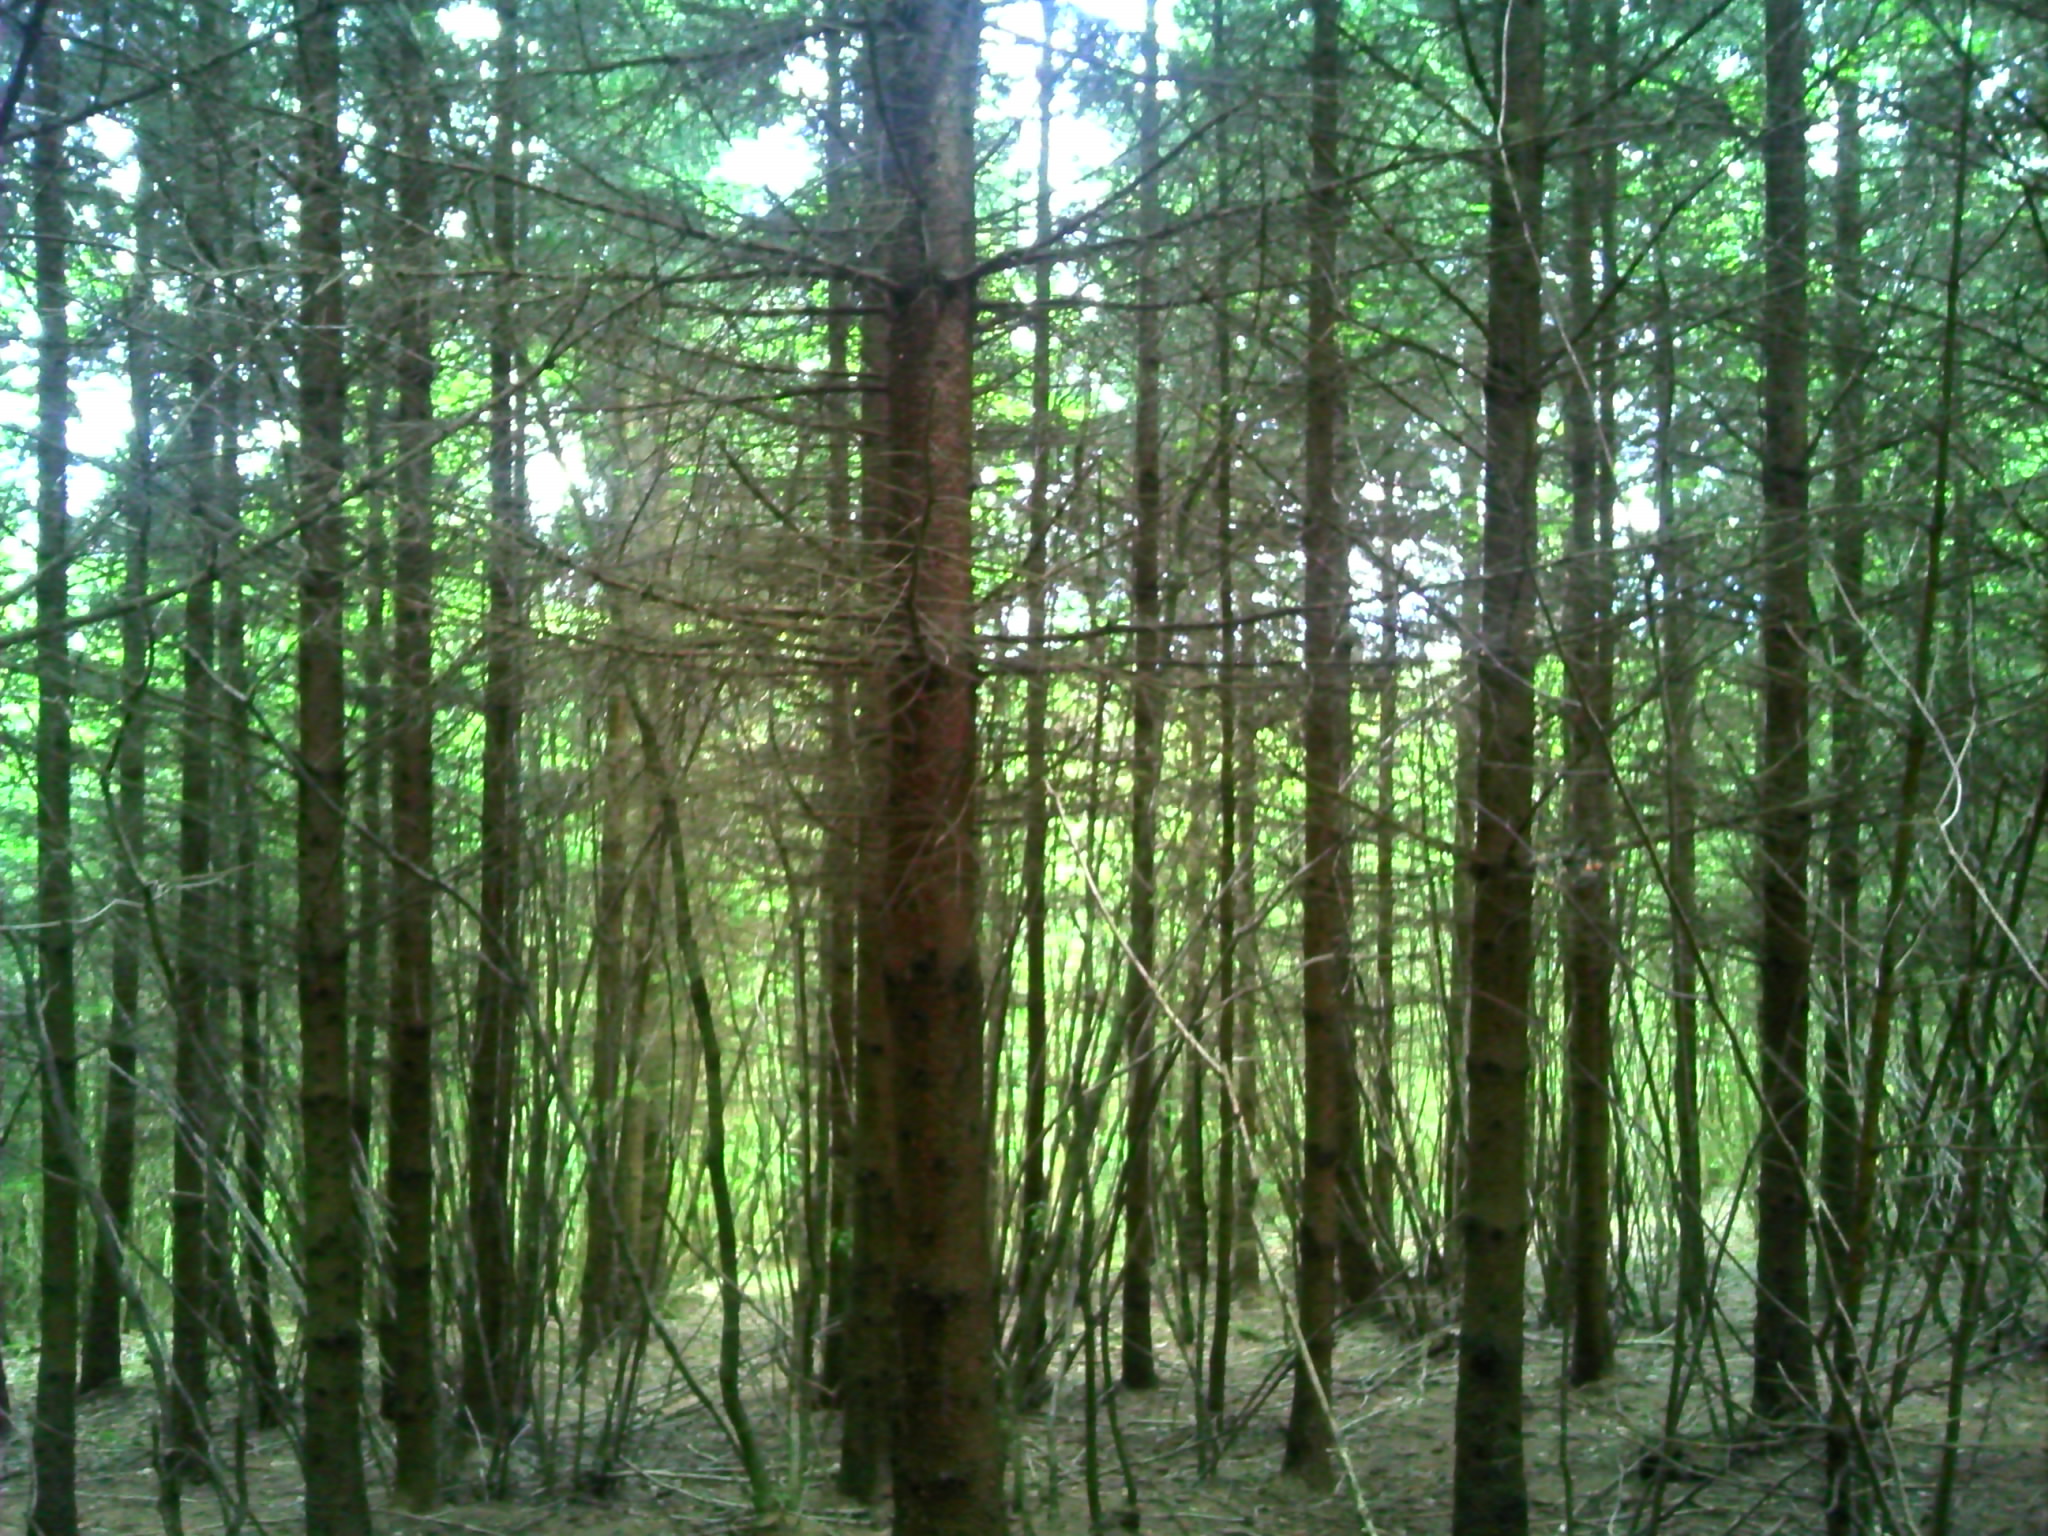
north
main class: Woodland
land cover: Spruce dominated coniferous woodland
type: exotic forest
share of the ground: > 75 %
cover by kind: coniferous forest trees 75 %, broadleaved forest trees 25 %
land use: Forestry
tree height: > 5 m
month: May
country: LU
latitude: 49.9321
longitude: 5.9450
